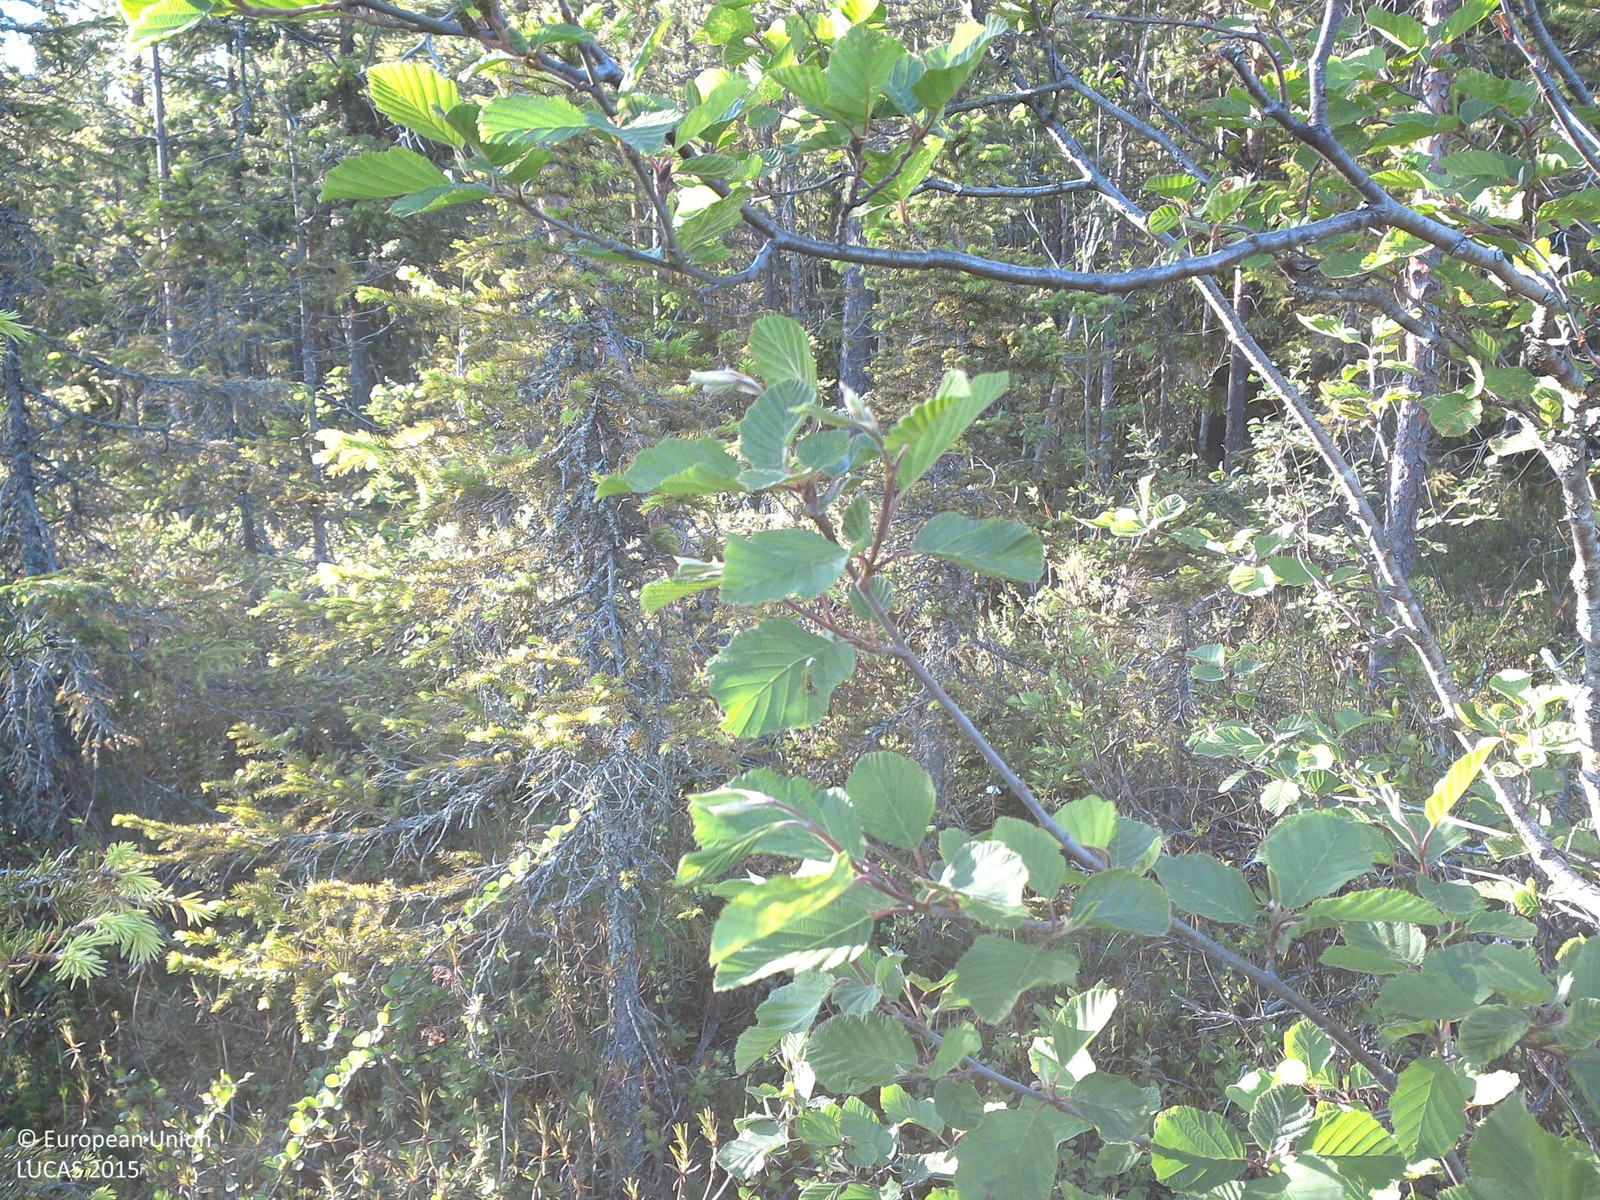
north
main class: Woodland
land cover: Pine dominated coniferous woodland
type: boreal forest
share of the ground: 10 - 25 %
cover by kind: shrubs 70 %, coniferous forest trees 20 %, herbaceous plants 10 %
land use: Semi-natural and natural areas not in use
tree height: > 5 m
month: June
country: SE
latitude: 66.6806
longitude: 22.9001
